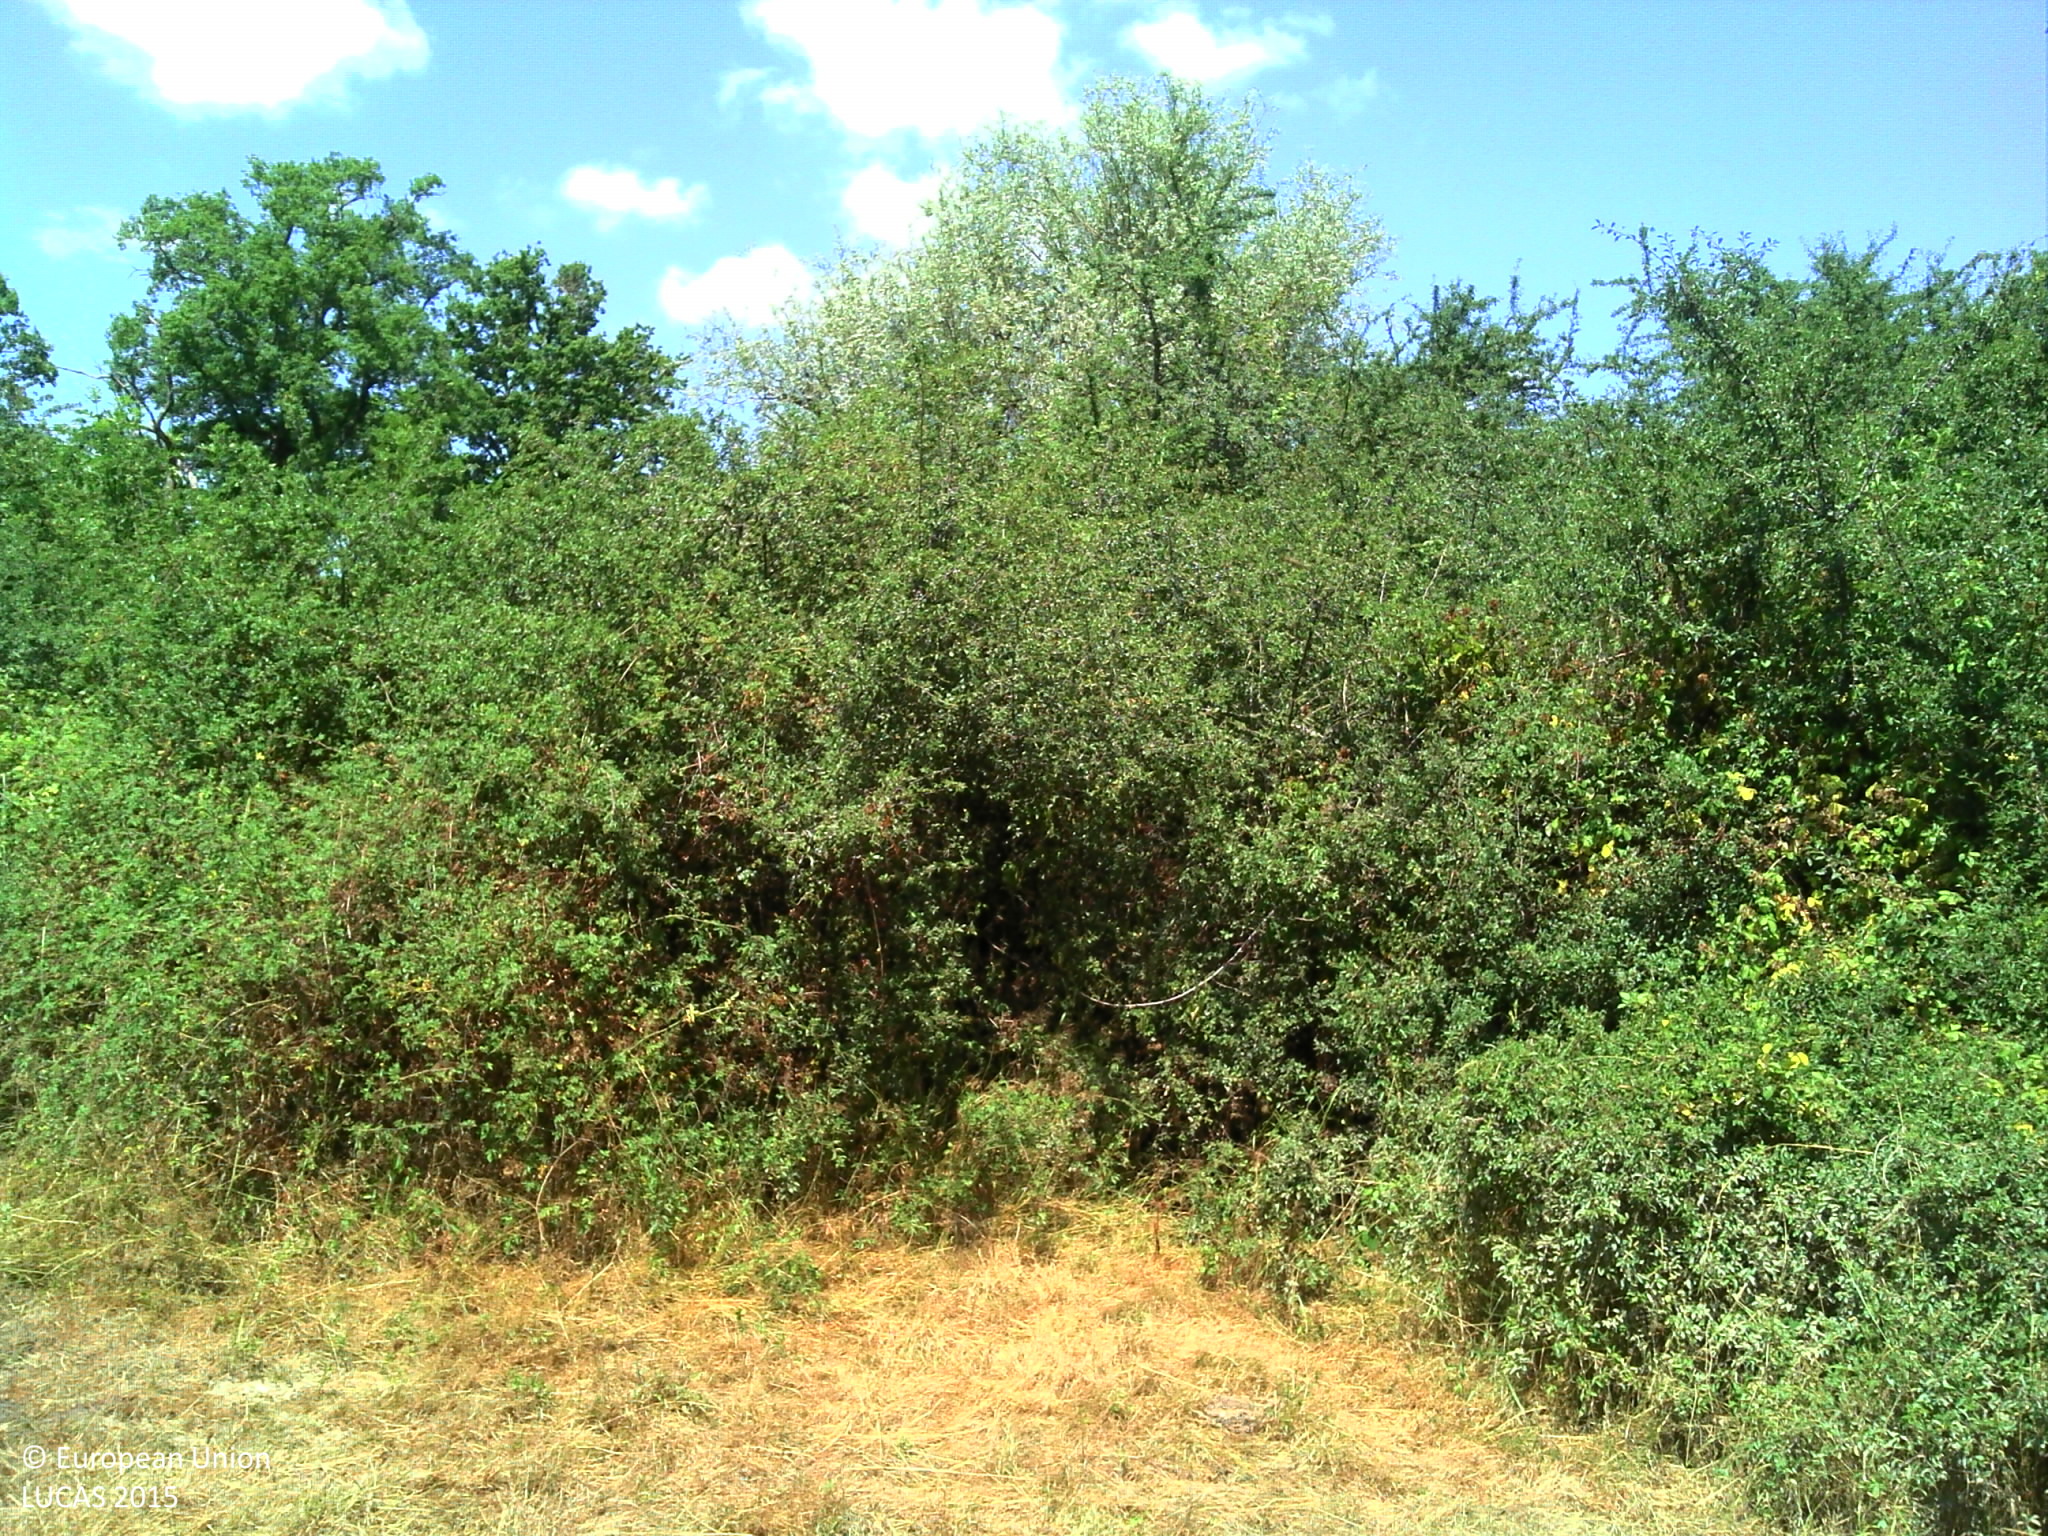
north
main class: Grassland
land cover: Grassland without tree/shrub cover
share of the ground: > 75 %
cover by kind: herbaceous plants 95 %, shrubs 5 %
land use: Agriculture (excluding fallow land and kitchen gardens)
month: July
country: FR
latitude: 46.8645
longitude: 3.6097
